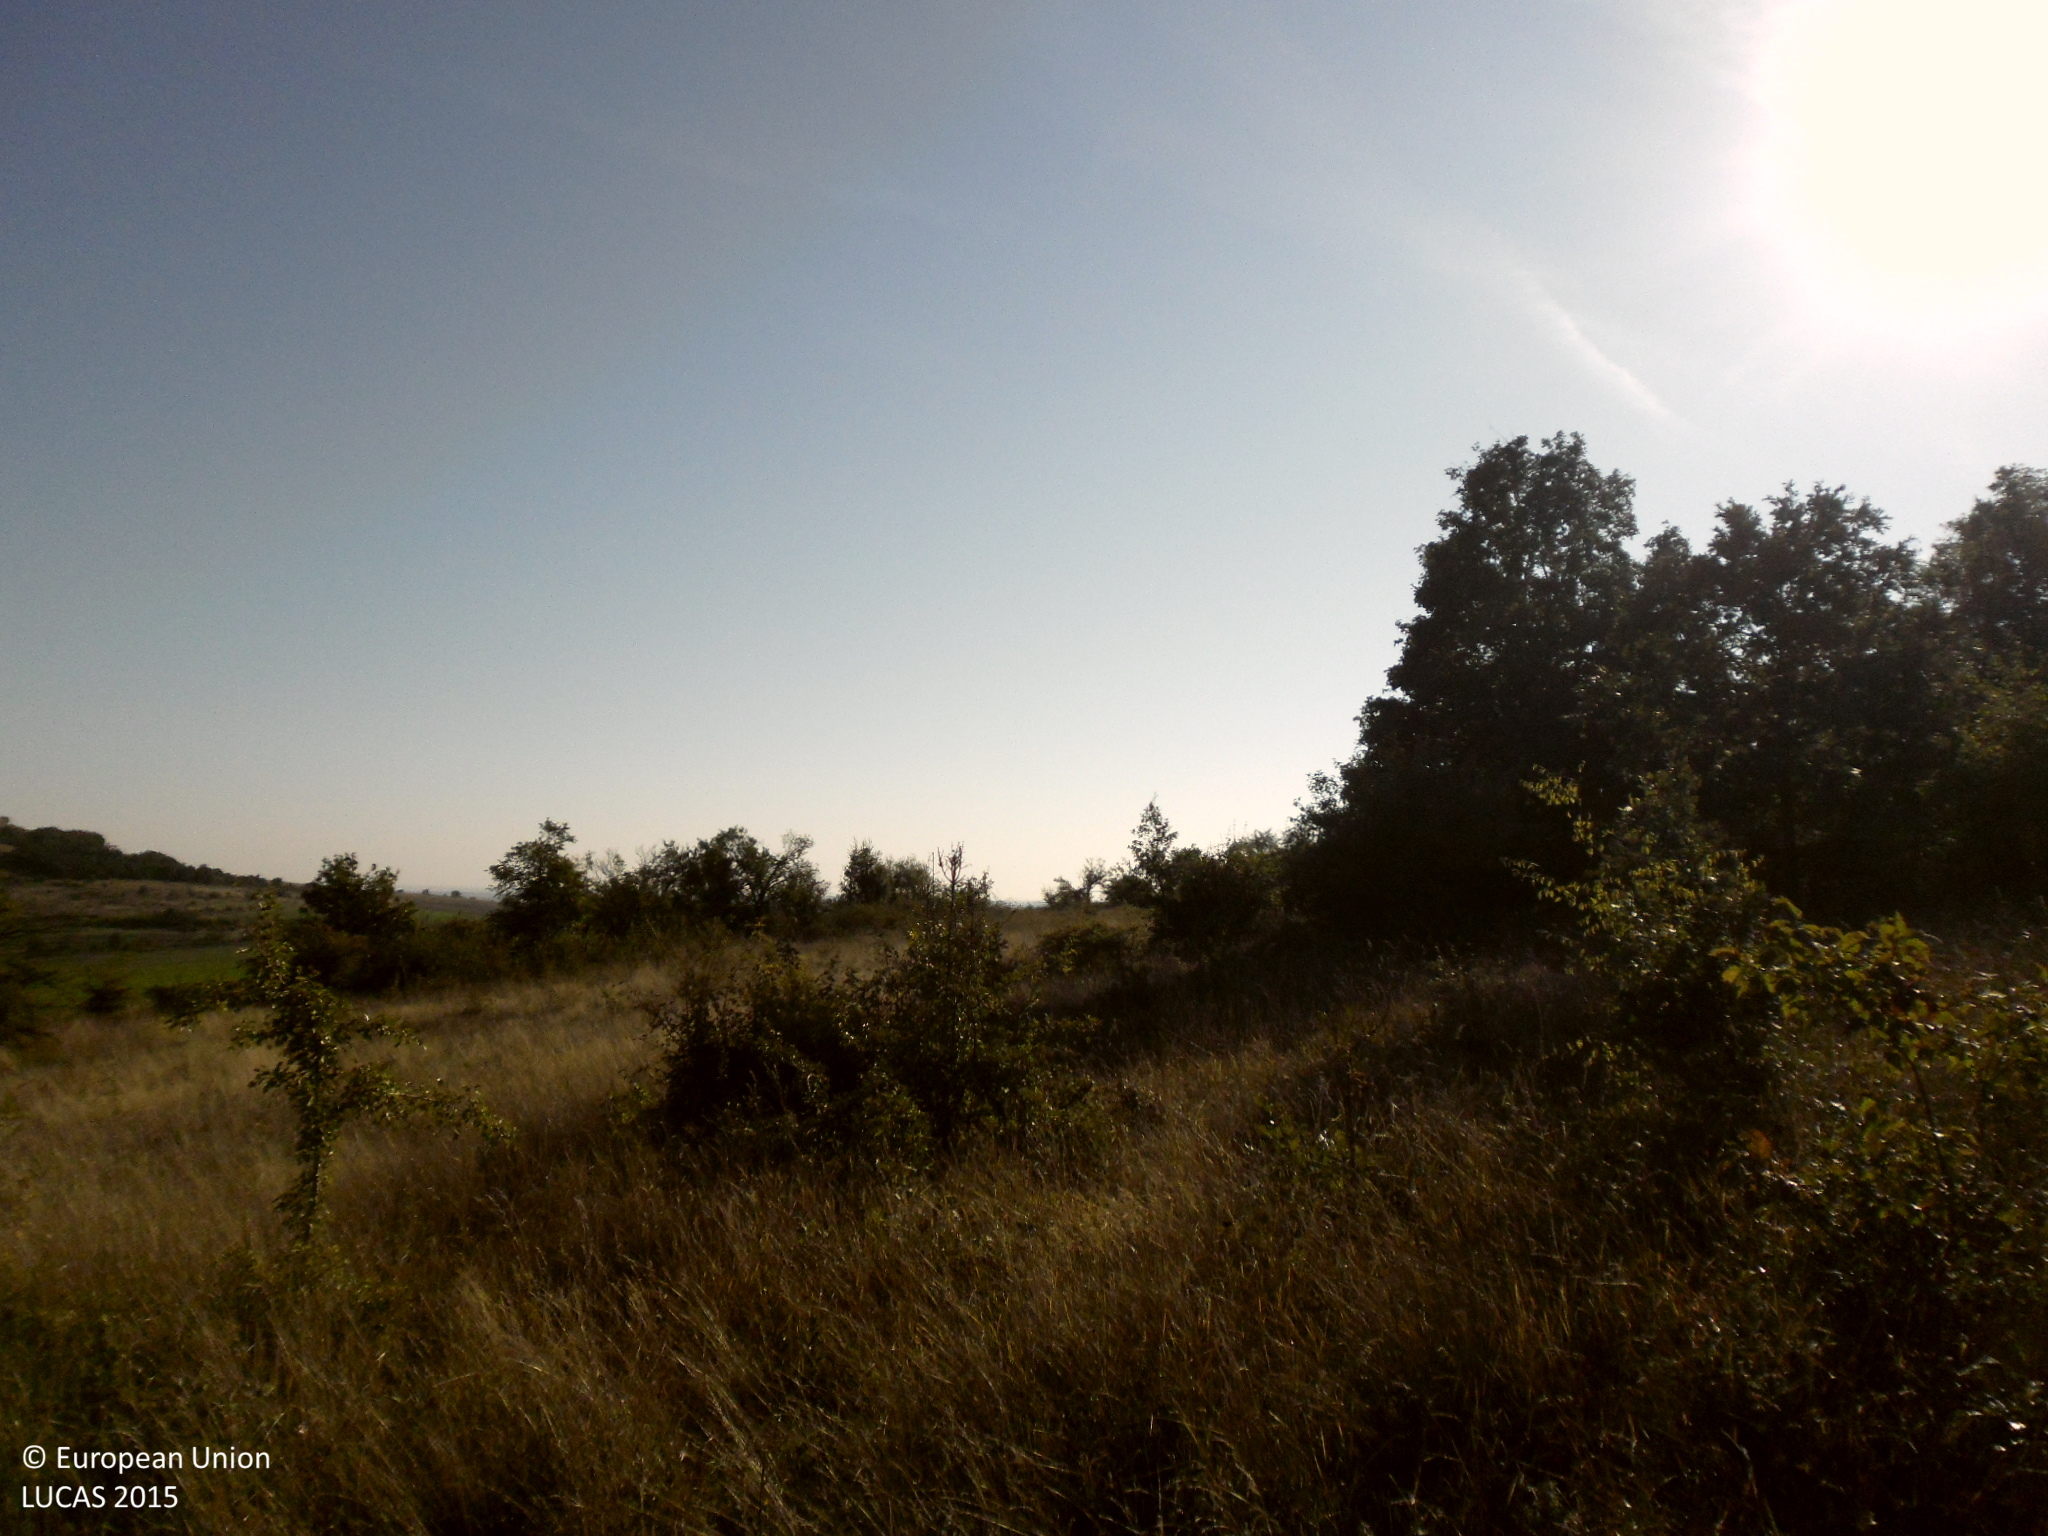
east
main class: Grassland
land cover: Grassland with sparse tree/shrub cover
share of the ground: > 75 %
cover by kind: herbaceous plants 90 %, broadleaved forest trees 5 %, shrubs 5 %
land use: Semi-natural and natural areas not in use
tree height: < 5 m
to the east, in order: Grassland with sparse tree/shrub cover; Broadleaved woodland; Grassland without tree/shrub cover; Tracks; Grass margins; Shrubland without tree cover; Sunflower
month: October
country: BG
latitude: 43.5839
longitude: 22.8540
